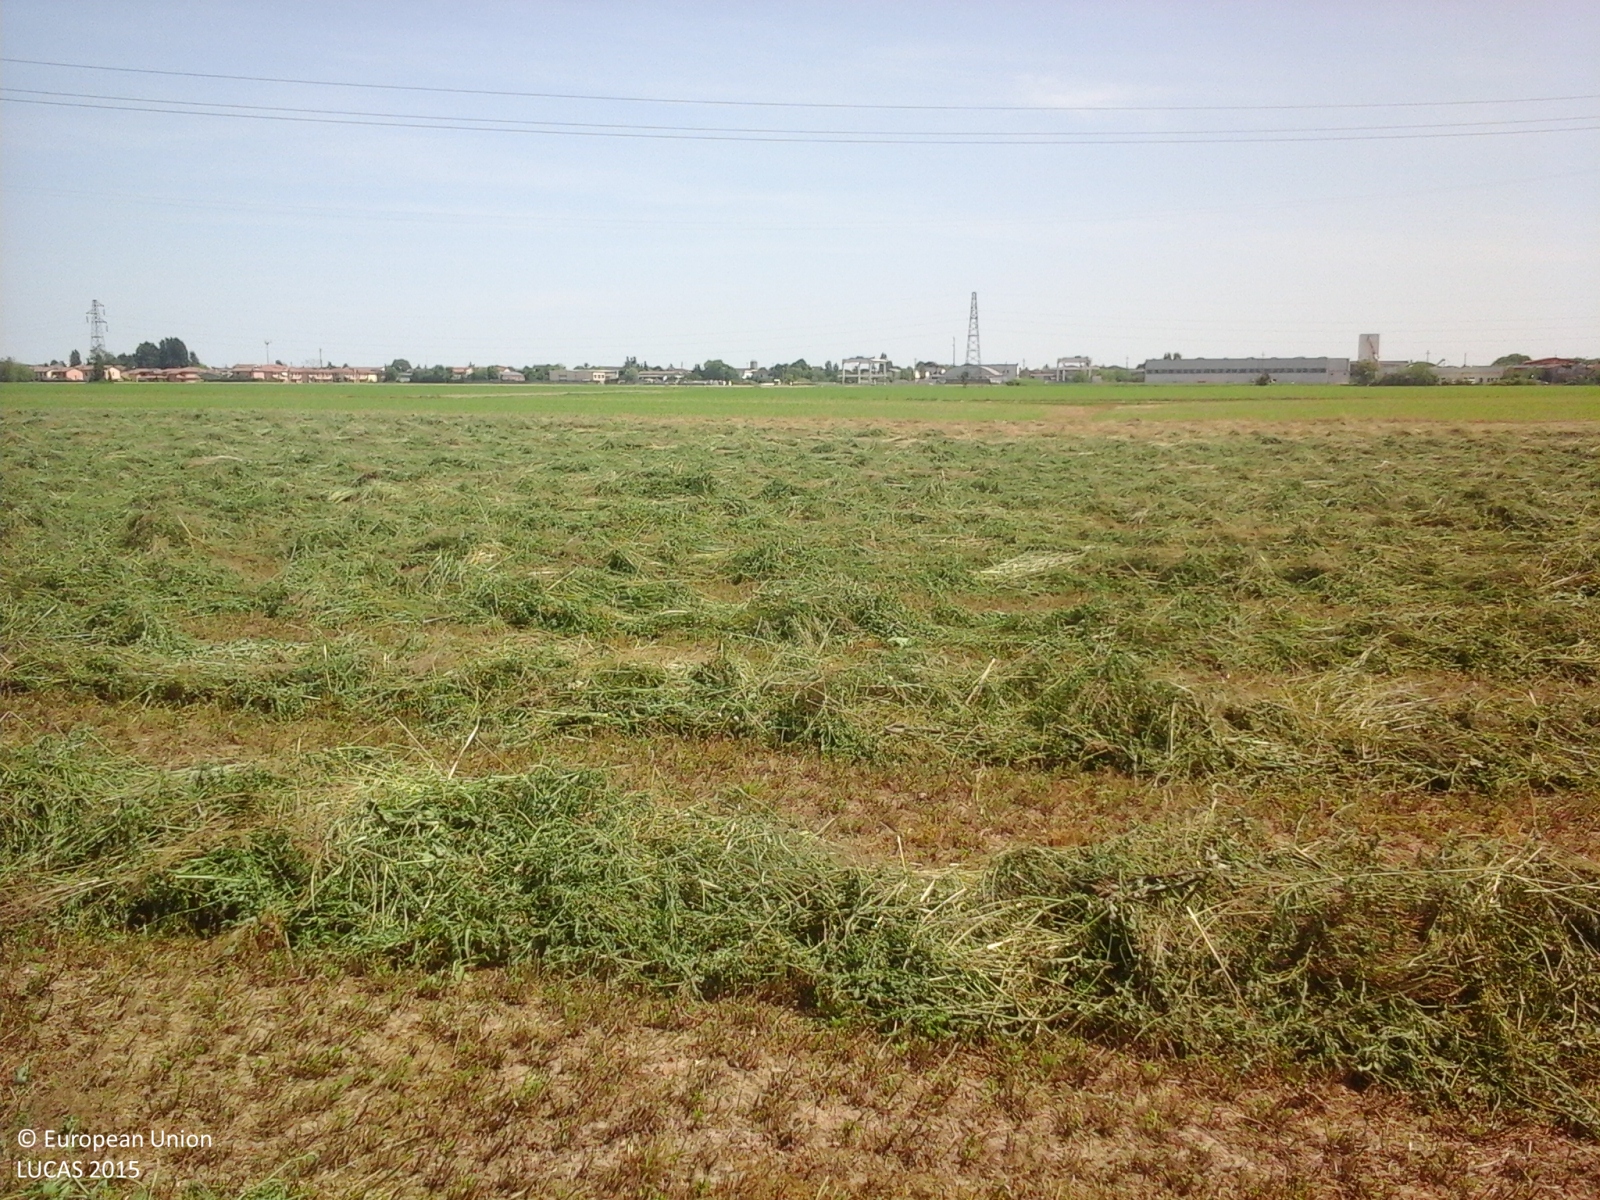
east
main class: Cropland
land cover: Lucerne
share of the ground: > 75 %
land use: Agriculture (excluding fallow land and kitchen gardens)
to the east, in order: Lucerne; Electric lines; Lucerne; Tracks; Maize; Ditches and canals; Tracks; Ditches and canals; Maize
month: May
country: IT
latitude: 44.9759
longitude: 11.1011
